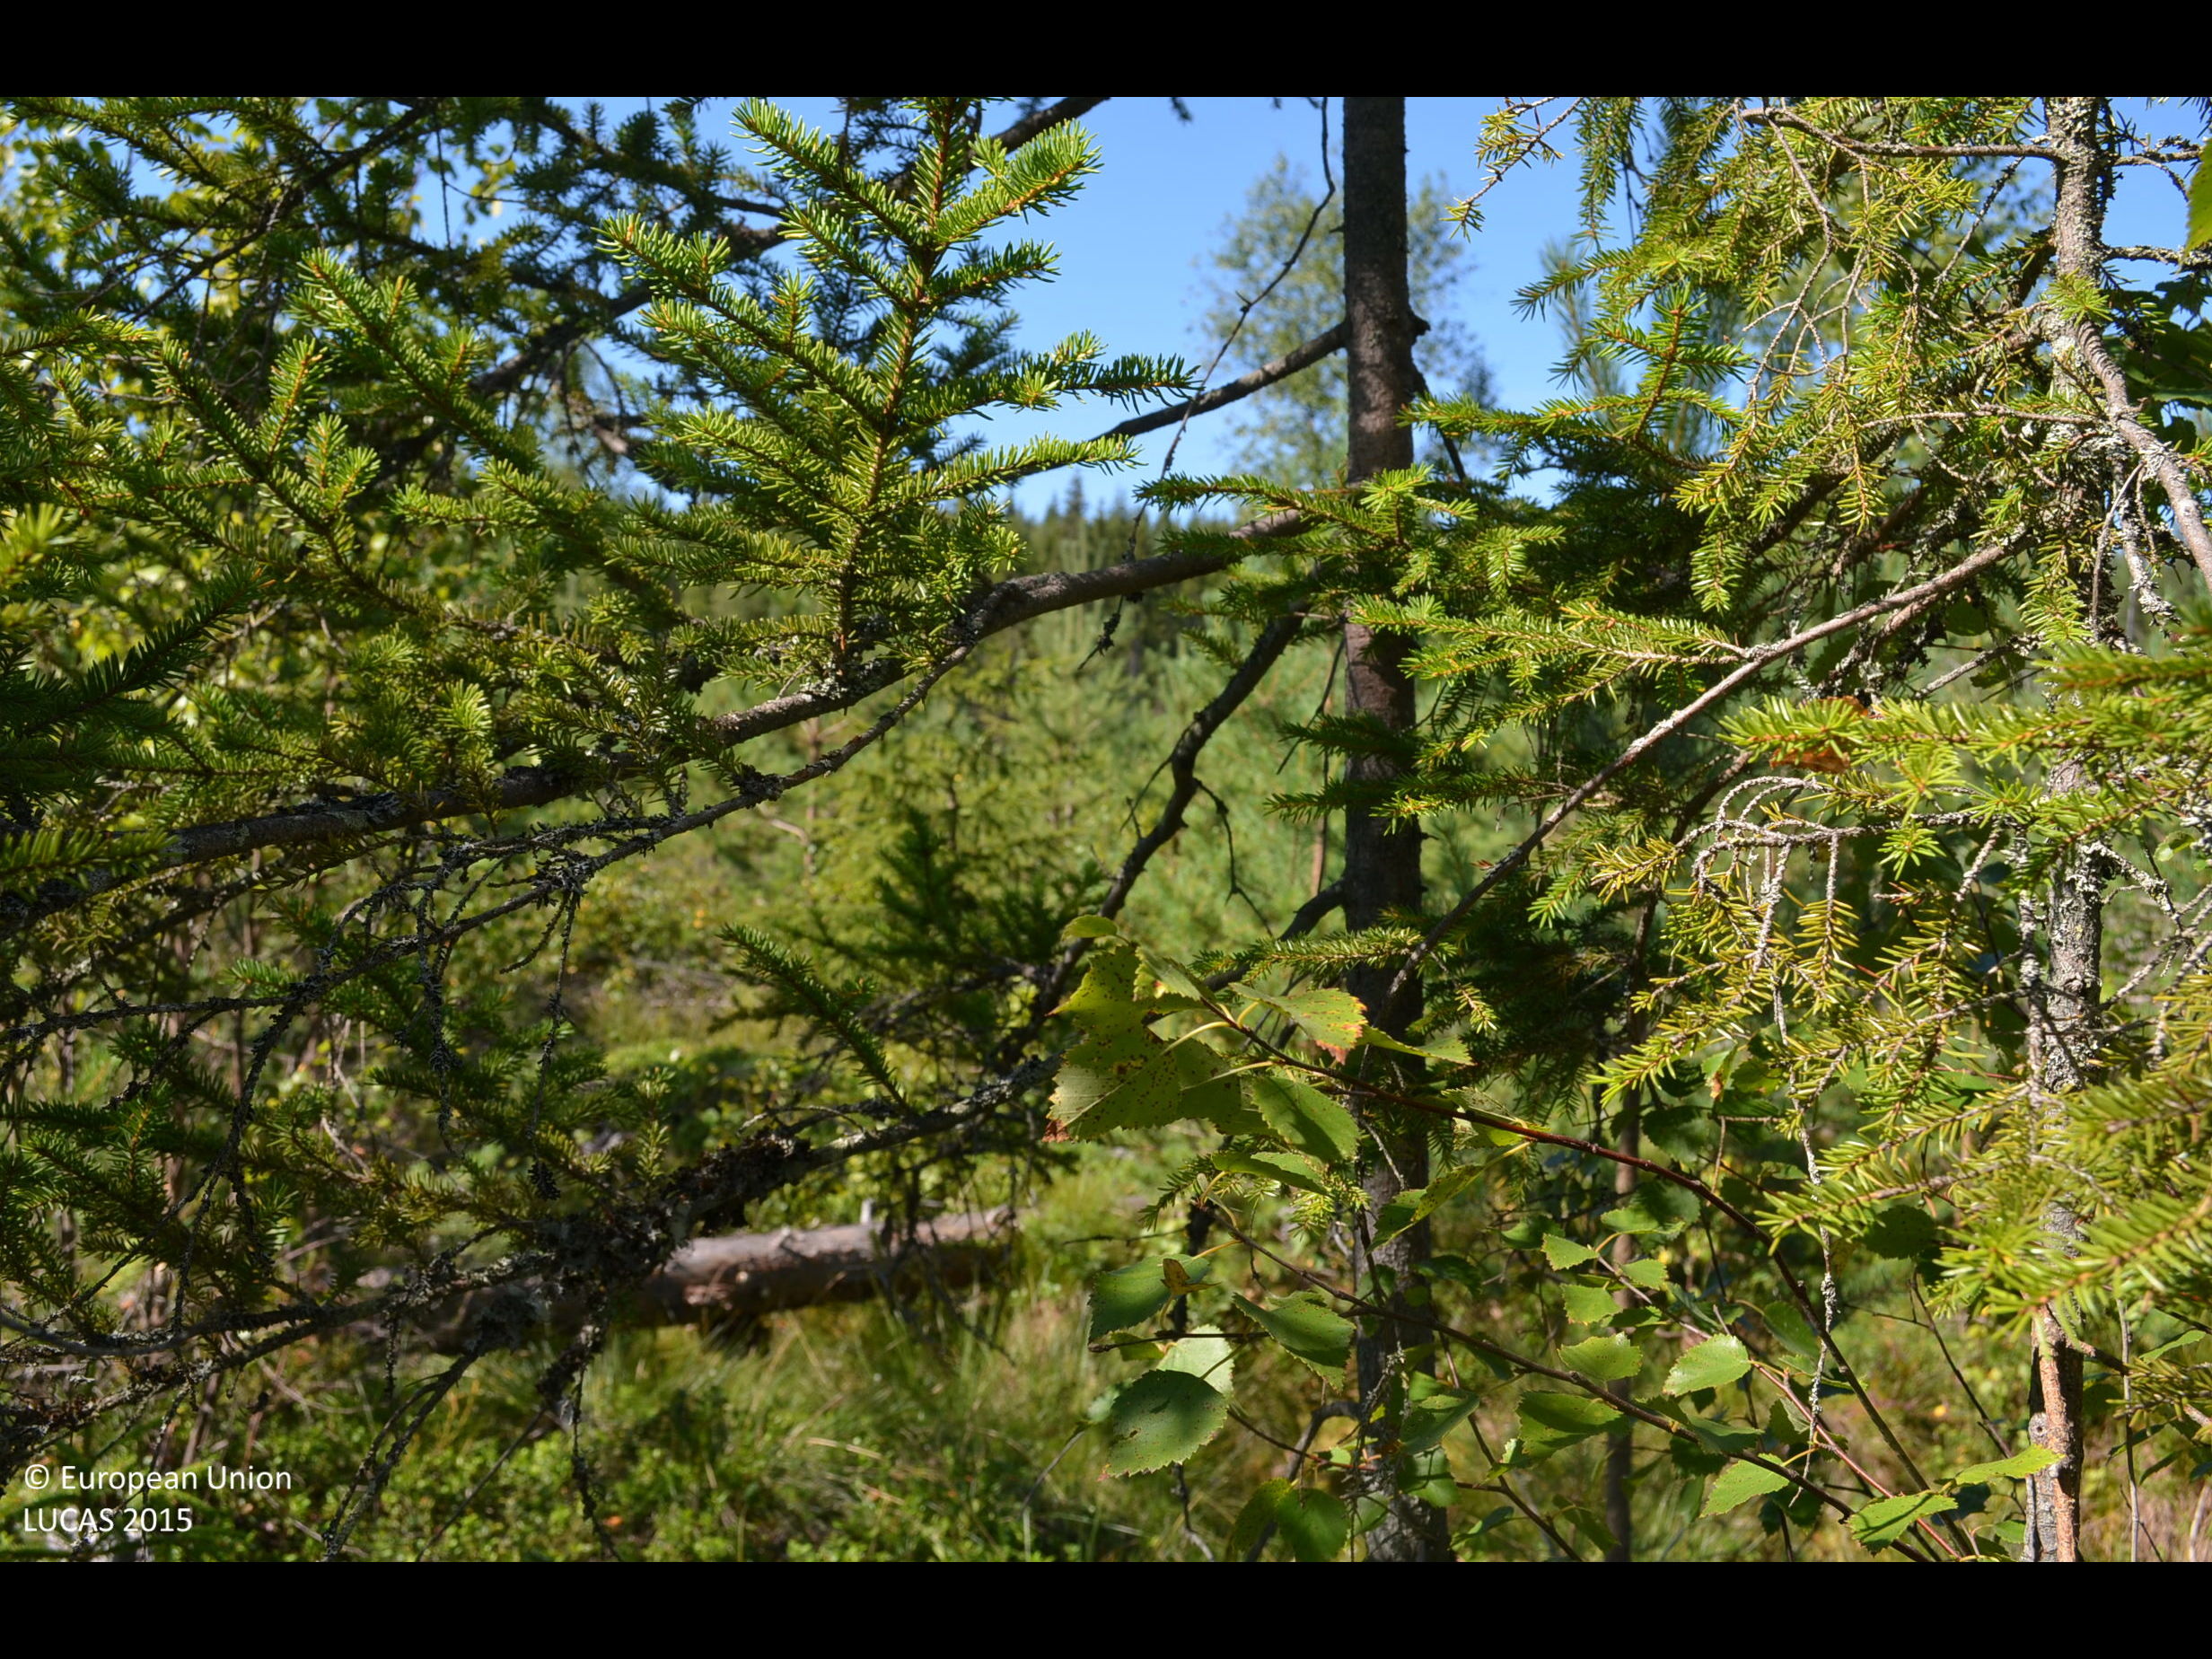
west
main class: Woodland
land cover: Other mixed woodland
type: boreal forest
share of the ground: 50 - 75 %
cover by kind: coniferous forest trees 50 %, shrubs 25 %, broadleaved forest trees 20 %, herbaceous plants 5 %
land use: Forestry
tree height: < 5 m
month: August
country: FI
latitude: 62.1486
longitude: 24.2676
